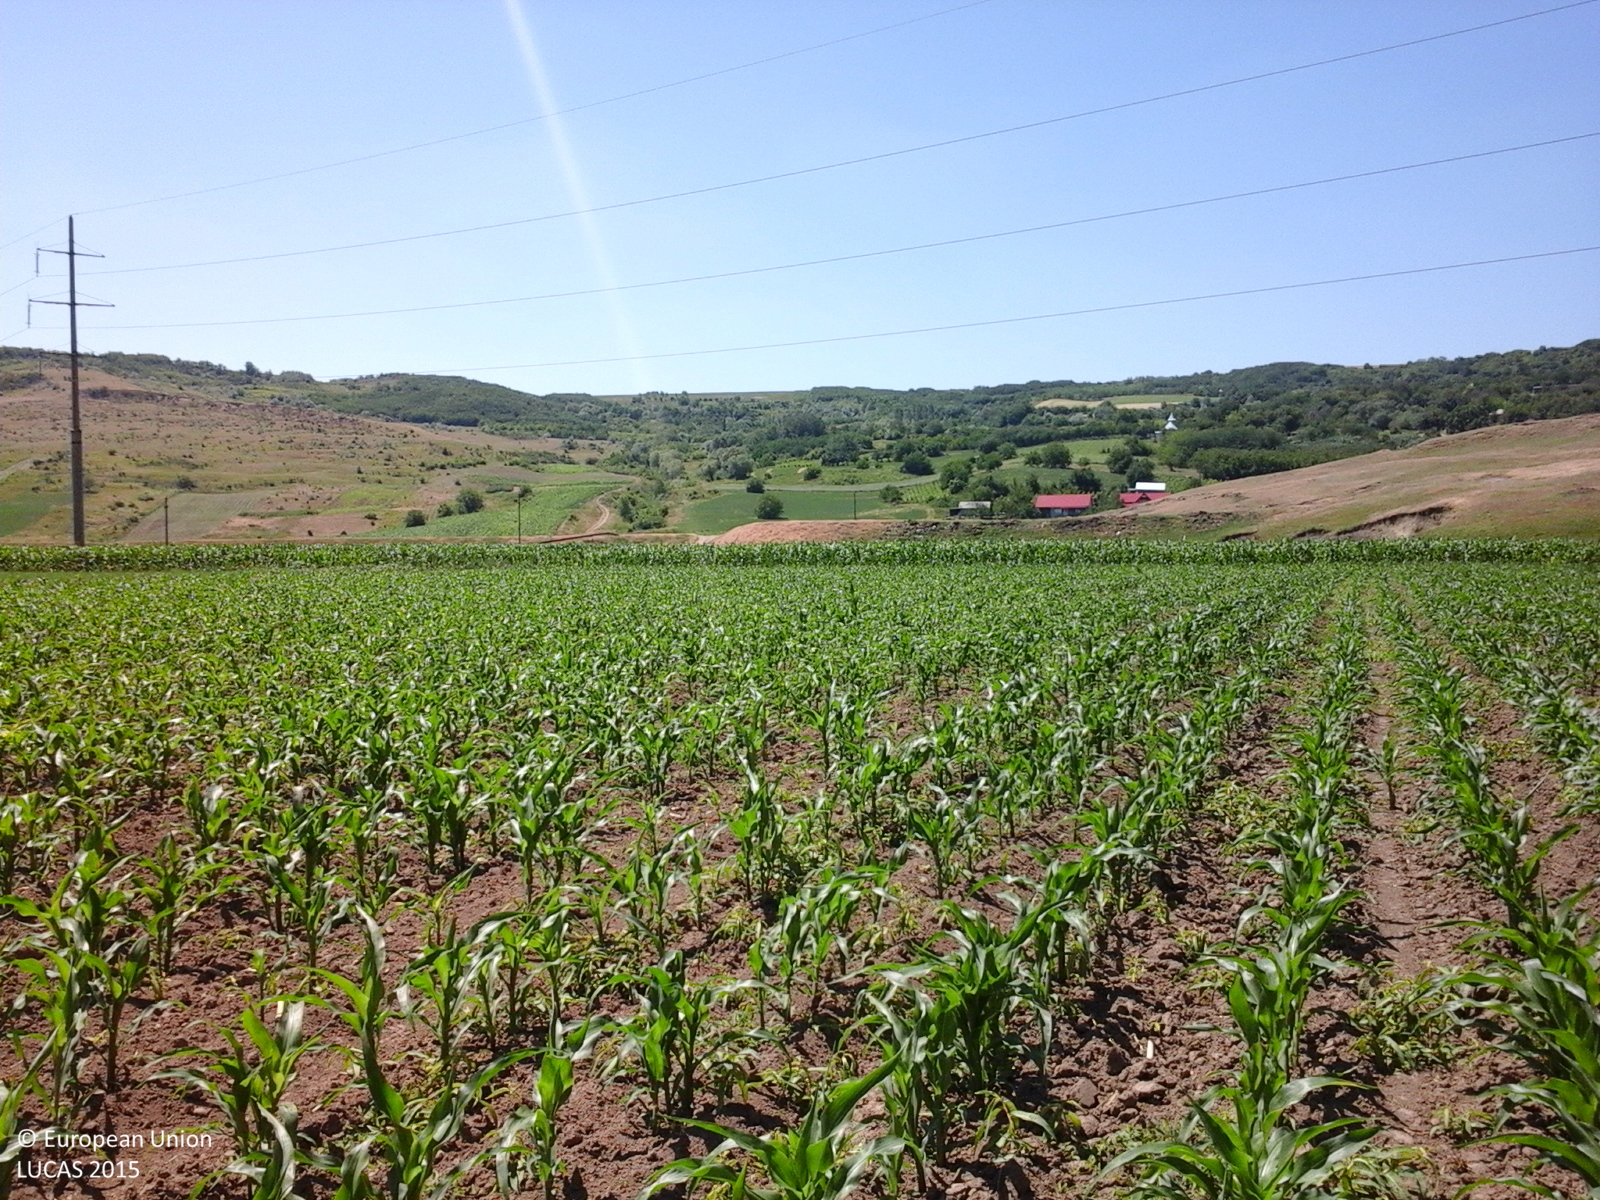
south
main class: Cropland
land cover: Maize
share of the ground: 25 - 50 %
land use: Agriculture (excluding fallow land and kitchen gardens)
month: June
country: RO
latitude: 46.9881
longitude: 27.9716
